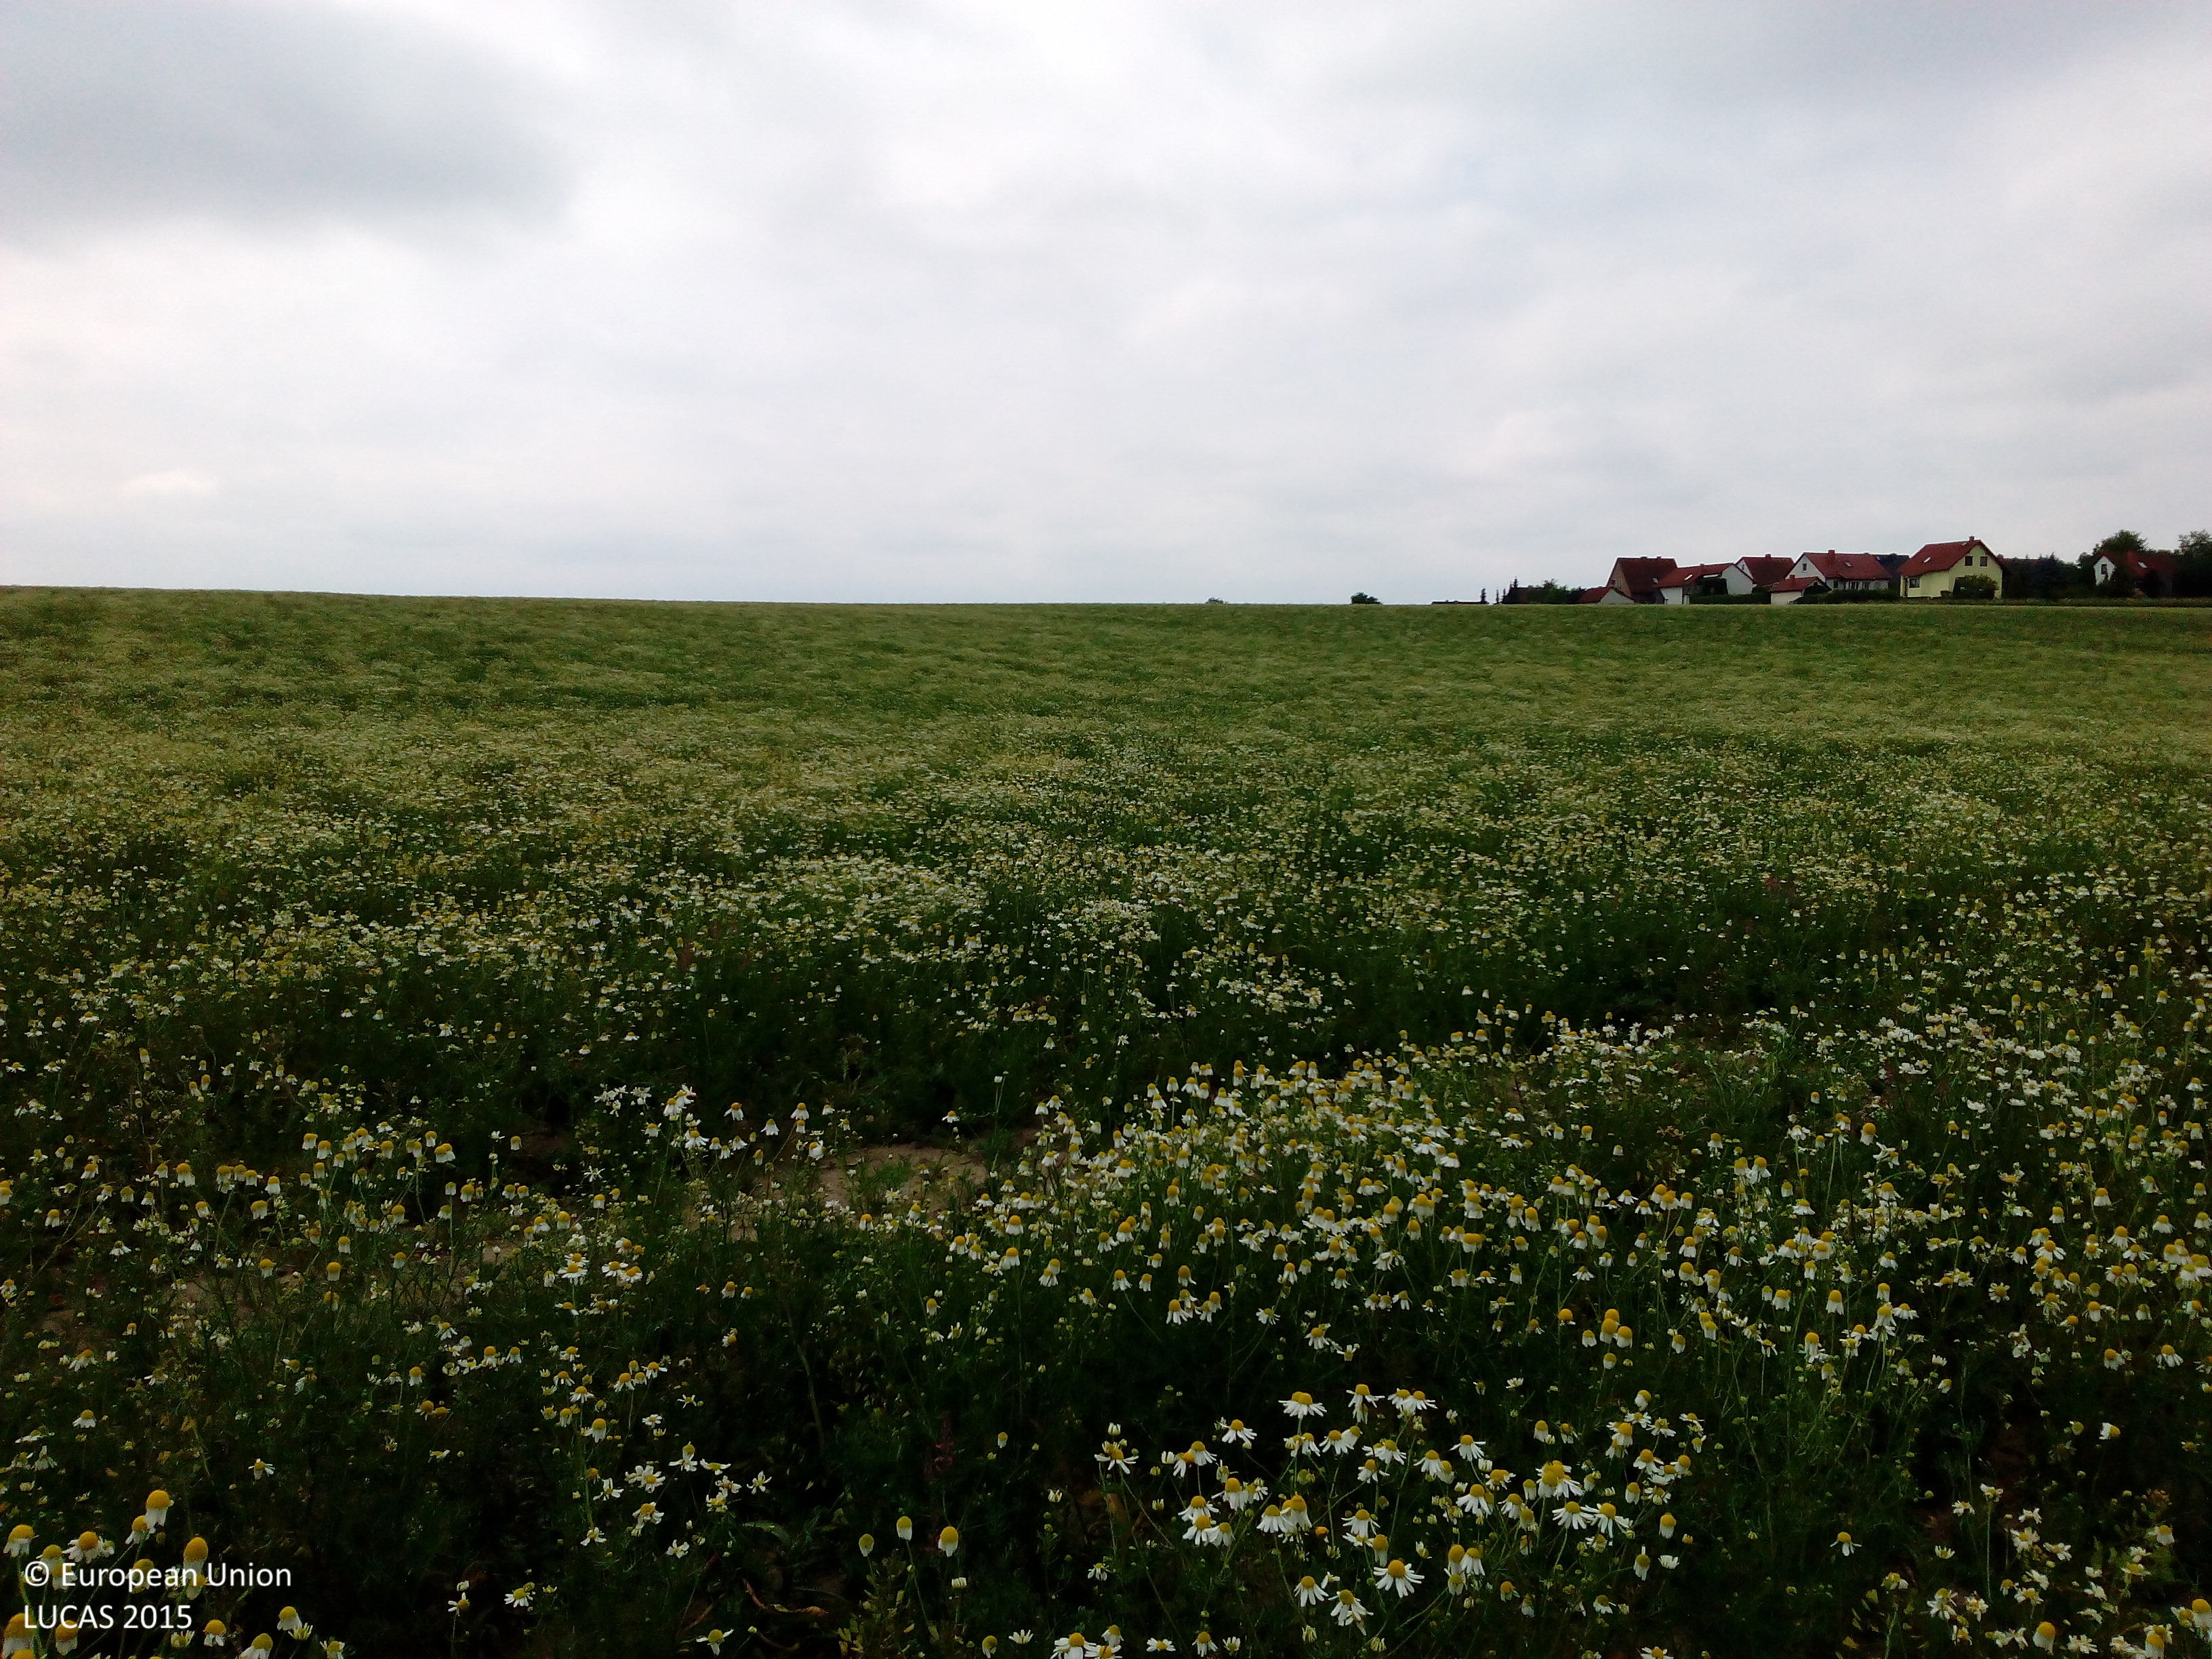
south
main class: Grassland
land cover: Spontaneously vegetated surfaces
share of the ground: > 75 %
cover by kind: herbaceous plants 80 %, unconsolidated bare surface 20 %
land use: Fallow land
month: June
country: DE
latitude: 50.7133
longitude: 11.5433
